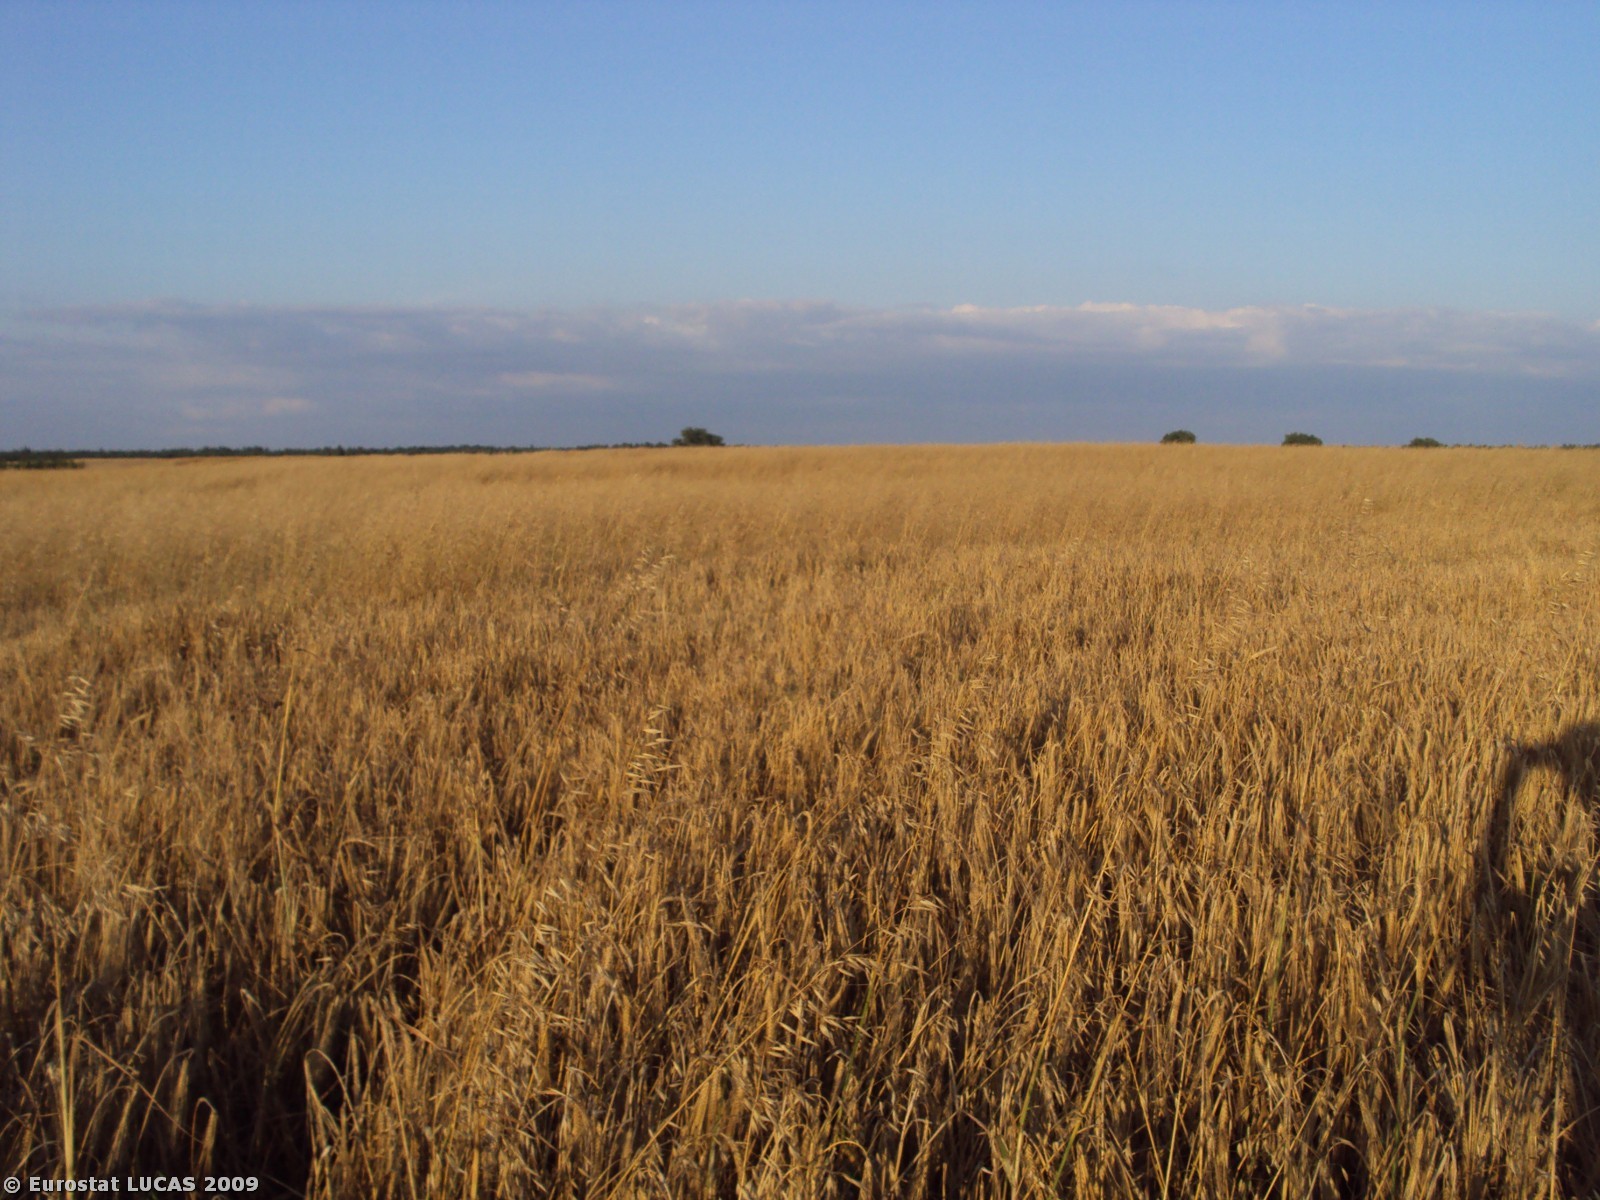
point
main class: Cropland
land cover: Triticale
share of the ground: > 75 %
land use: Agriculture (excluding fallow land and kitchen gardens)
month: August
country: PL
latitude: 53.3318
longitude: 16.5693
